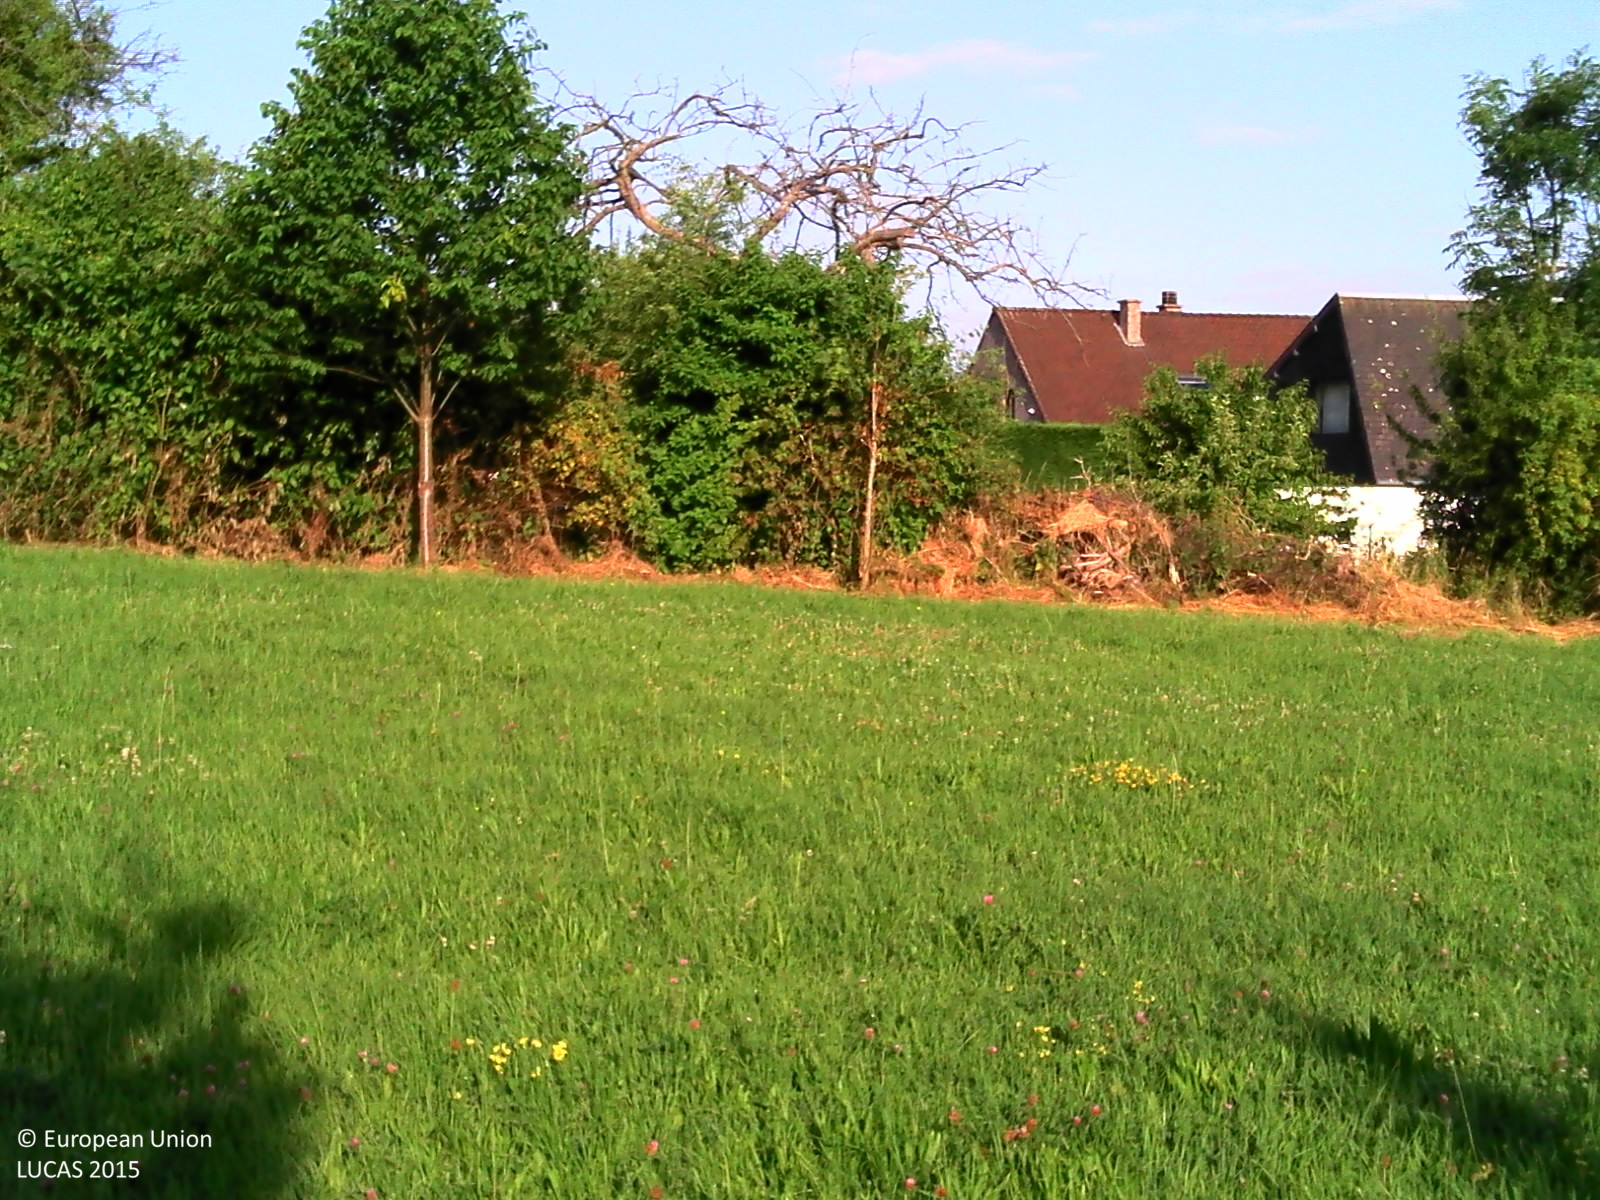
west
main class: Grassland
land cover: Grassland with sparse tree/shrub cover
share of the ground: > 75 %
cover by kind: herbaceous plants 95 %, broadleaved forest trees 5 %
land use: Residential
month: July
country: BE
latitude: 50.3365
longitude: 4.8124
